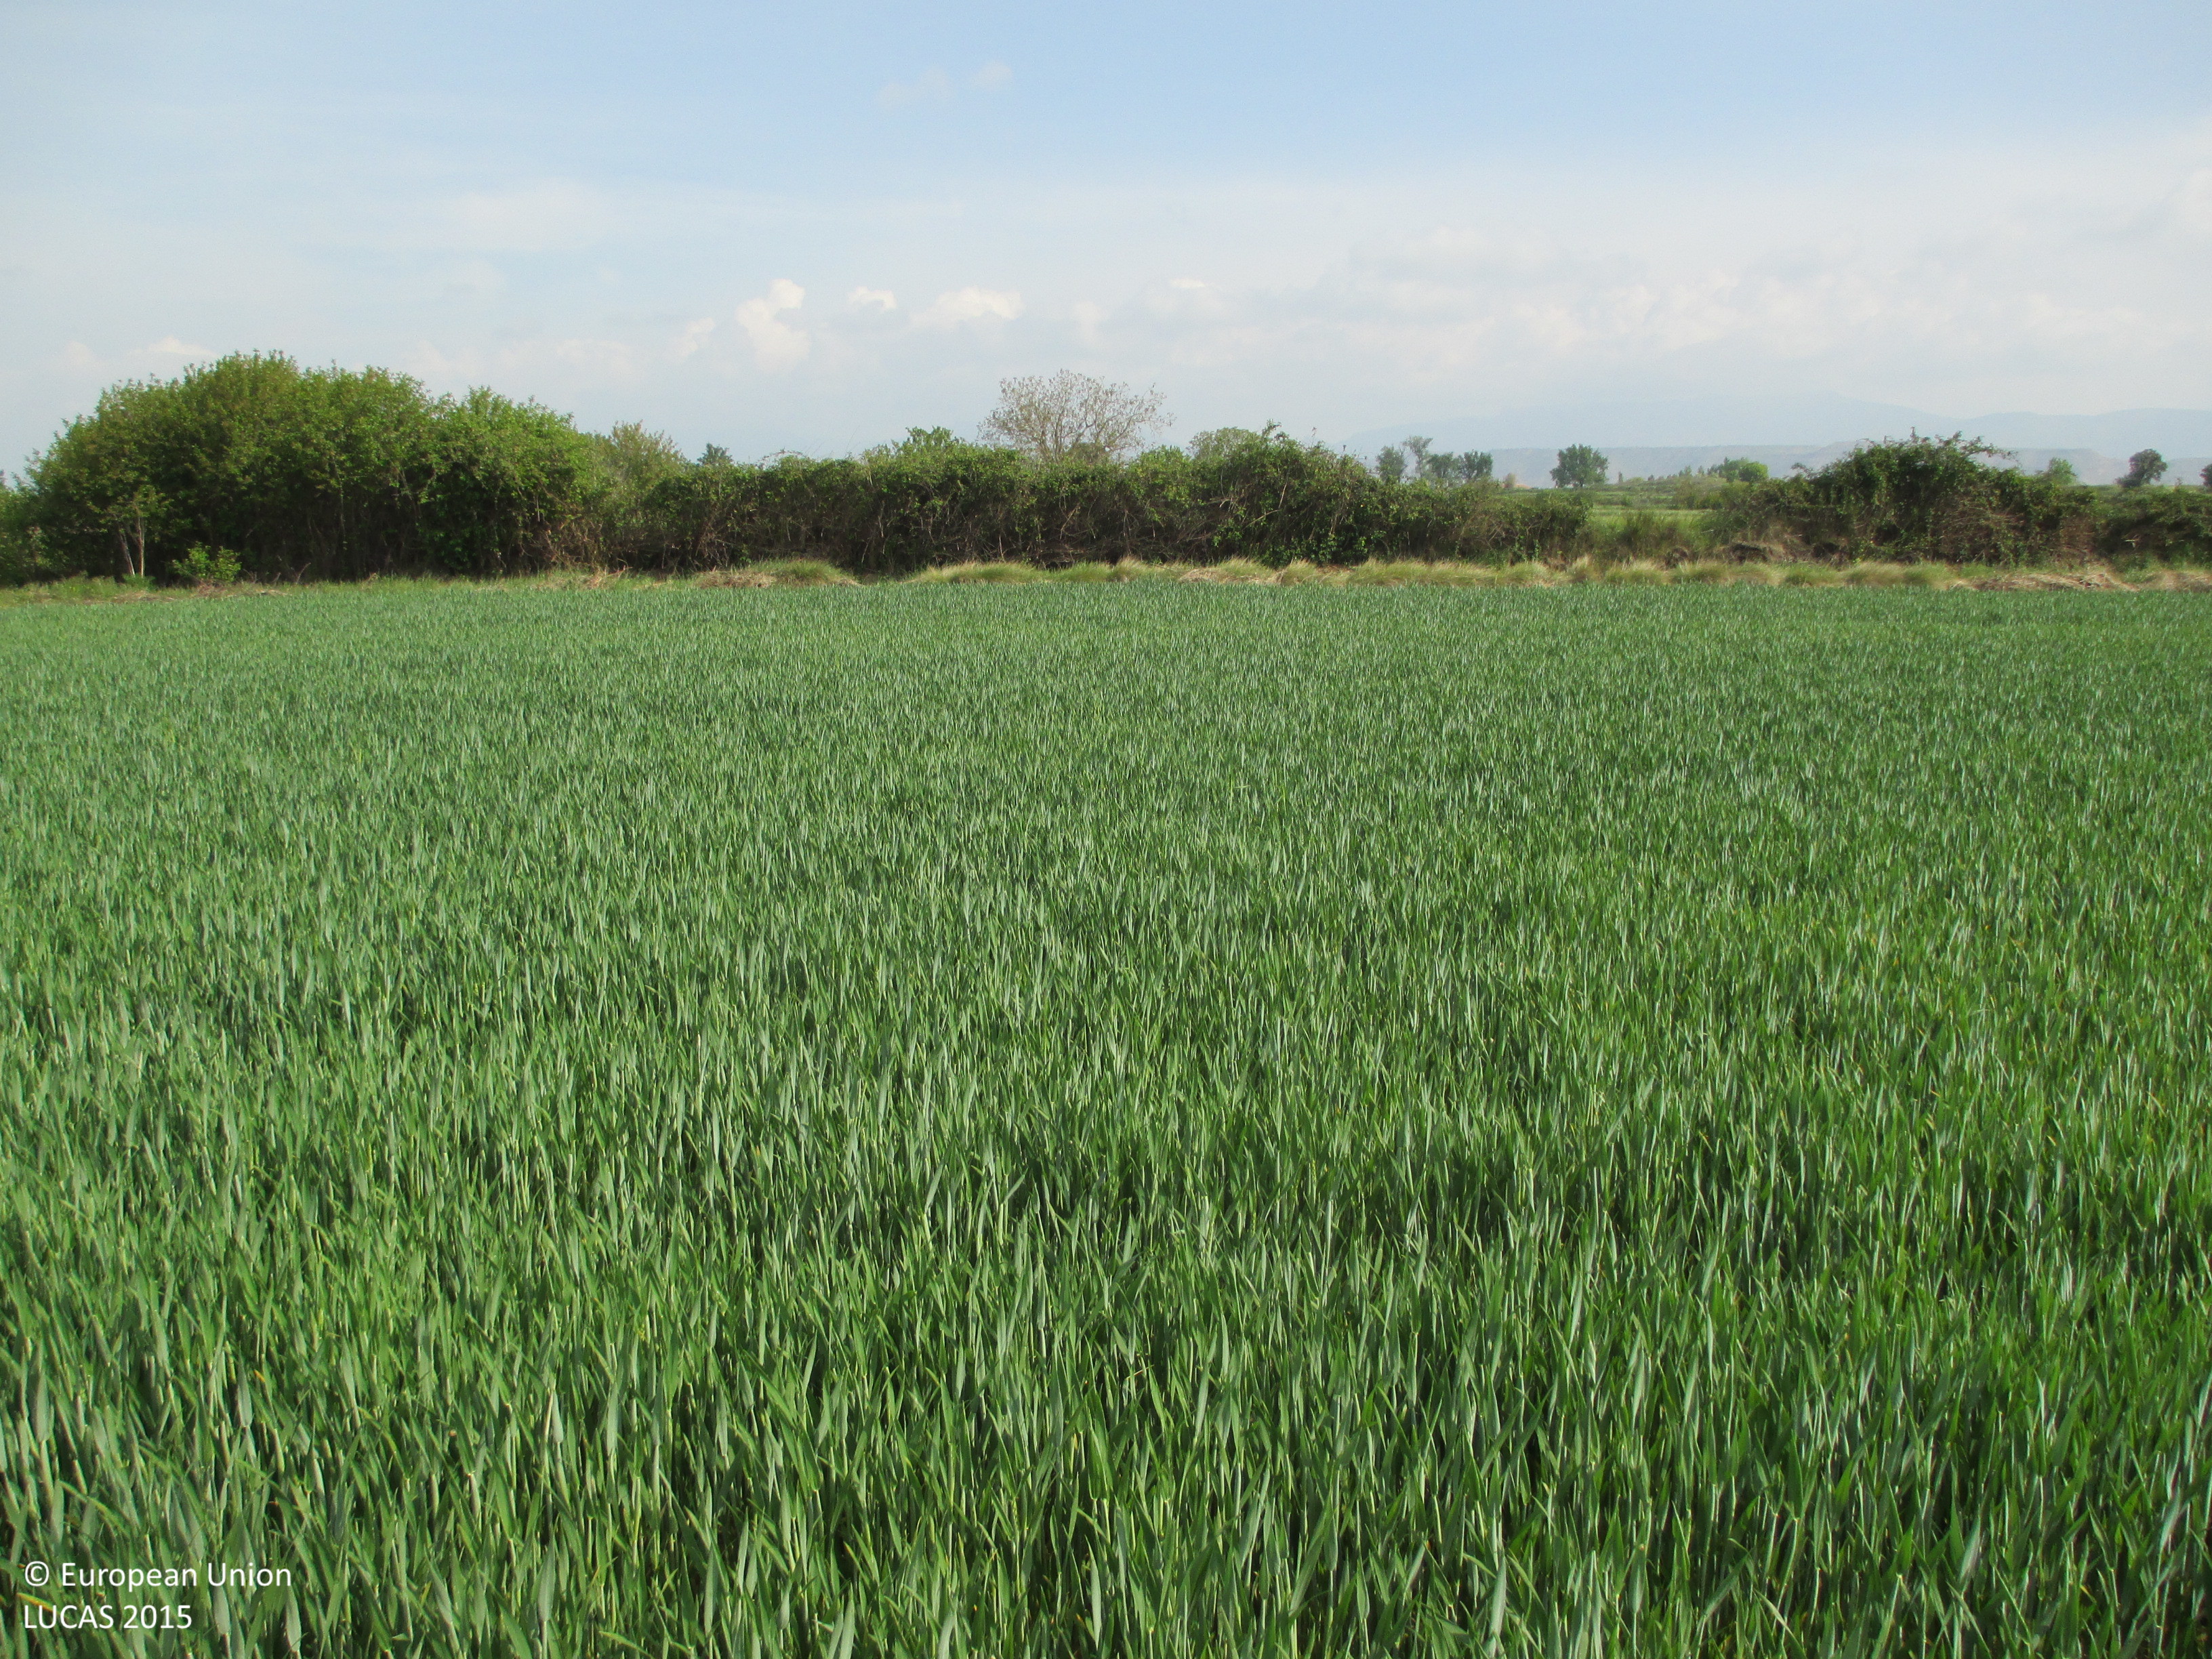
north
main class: Cropland
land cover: Durum wheat
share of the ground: > 75 %
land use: Agriculture (excluding fallow land and kitchen gardens)
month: April
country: ES
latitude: 42.1185
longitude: -0.3879
